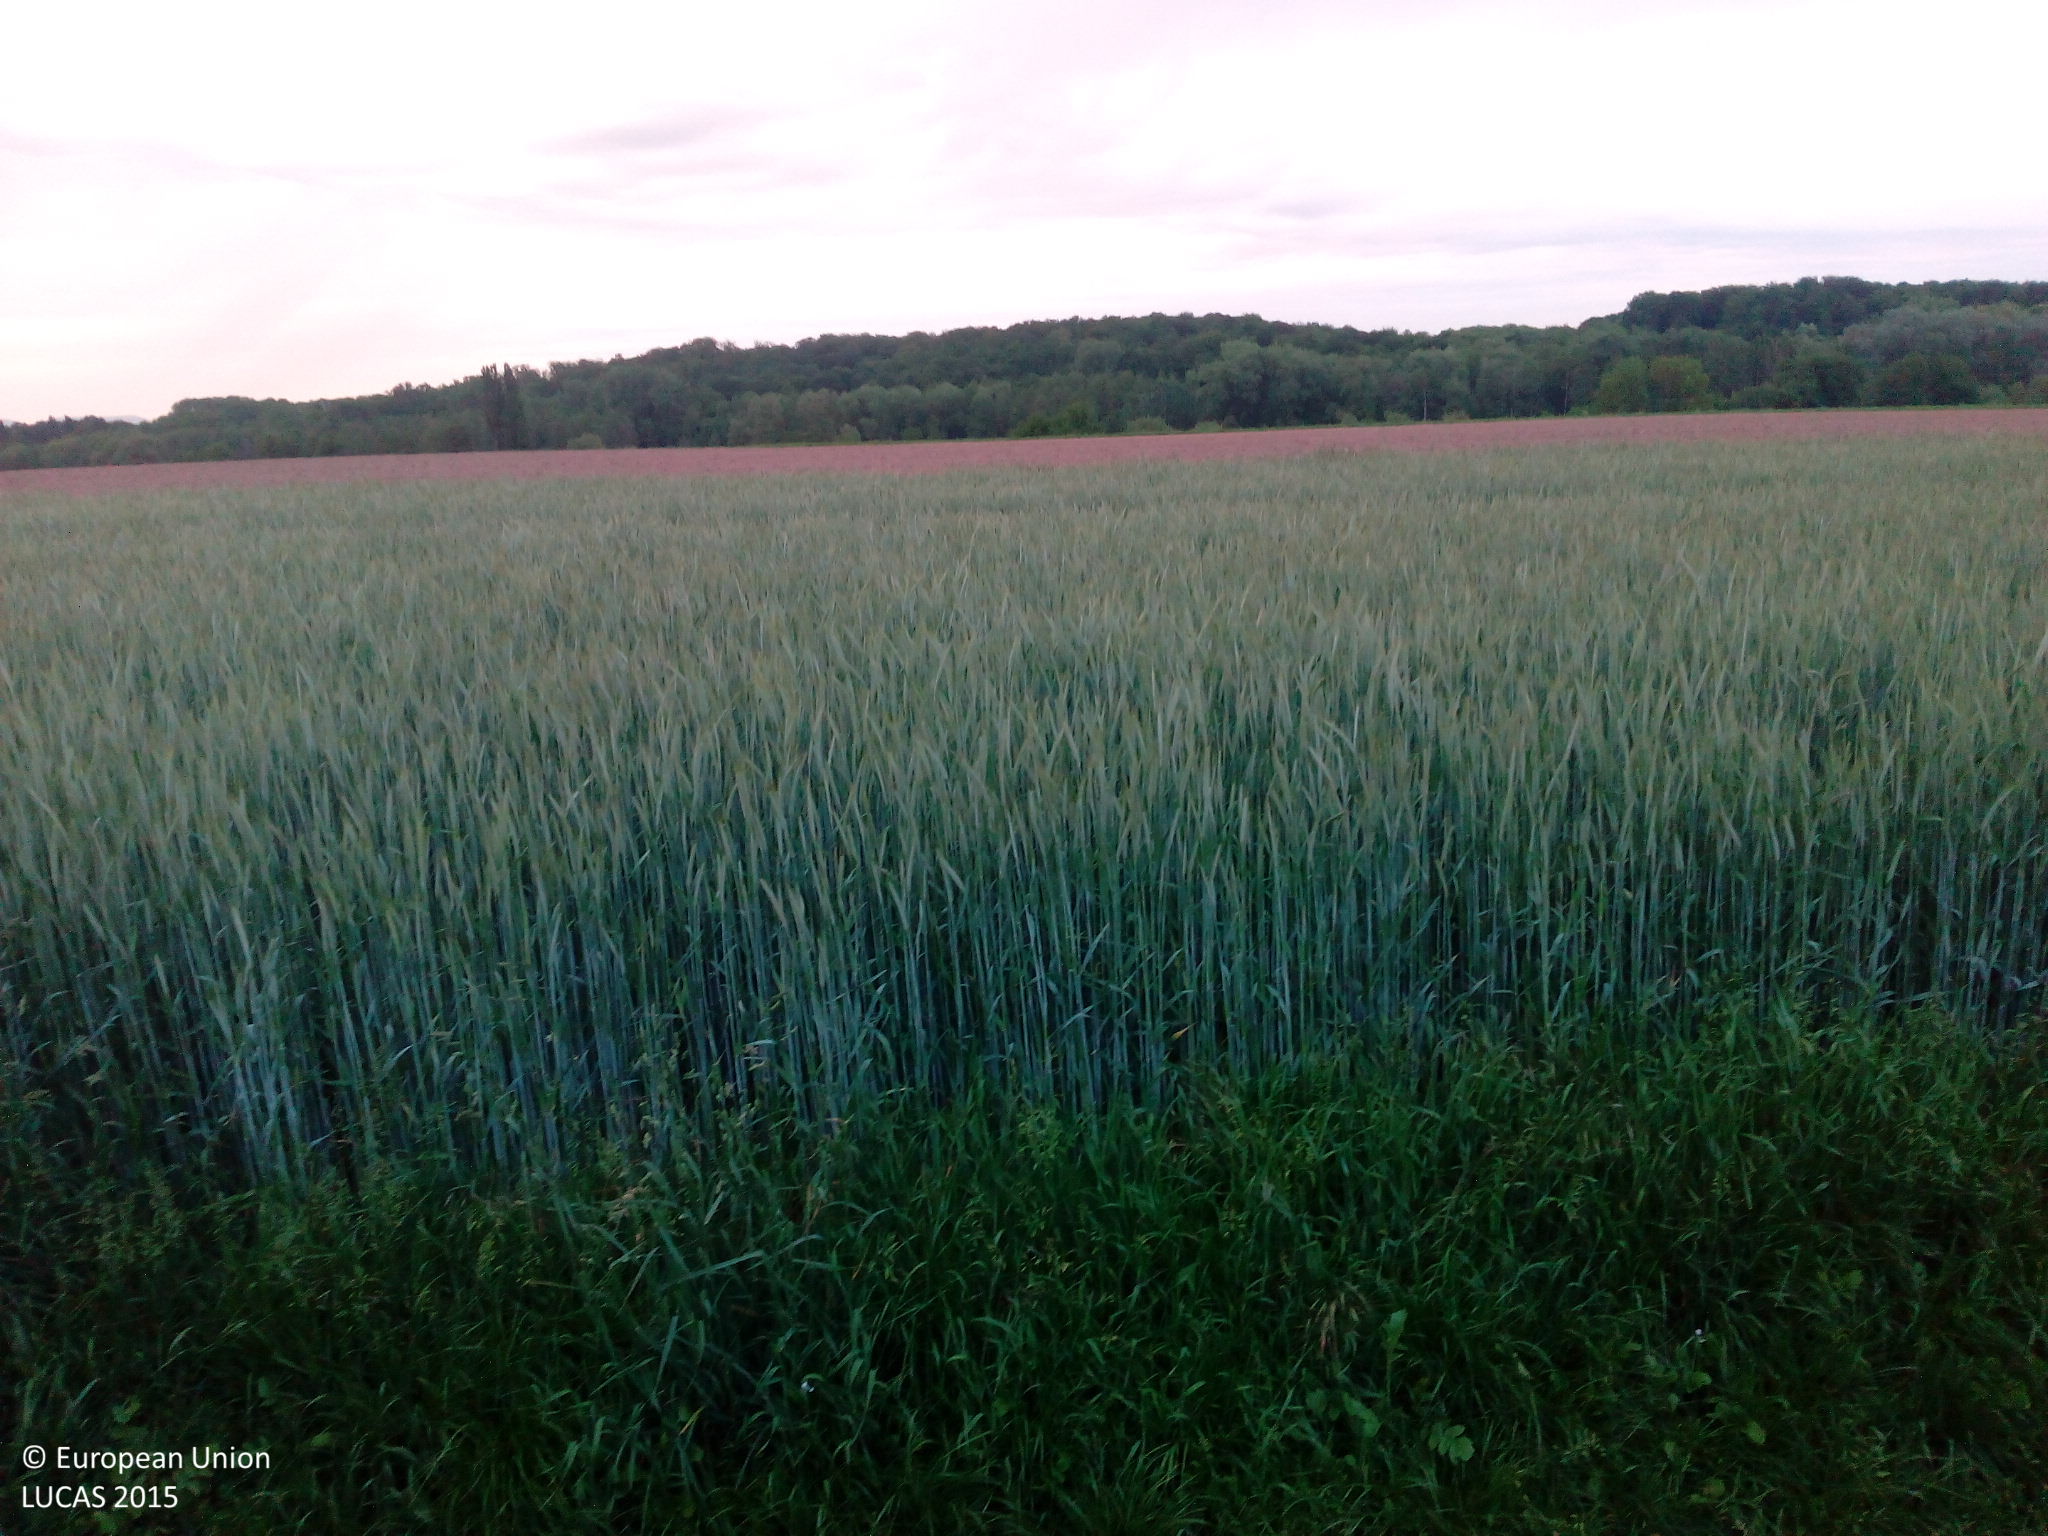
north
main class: Cropland
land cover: Rye
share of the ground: > 75 %
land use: Agriculture (excluding fallow land and kitchen gardens)
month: May
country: DE
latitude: 49.1065
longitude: 8.0692
